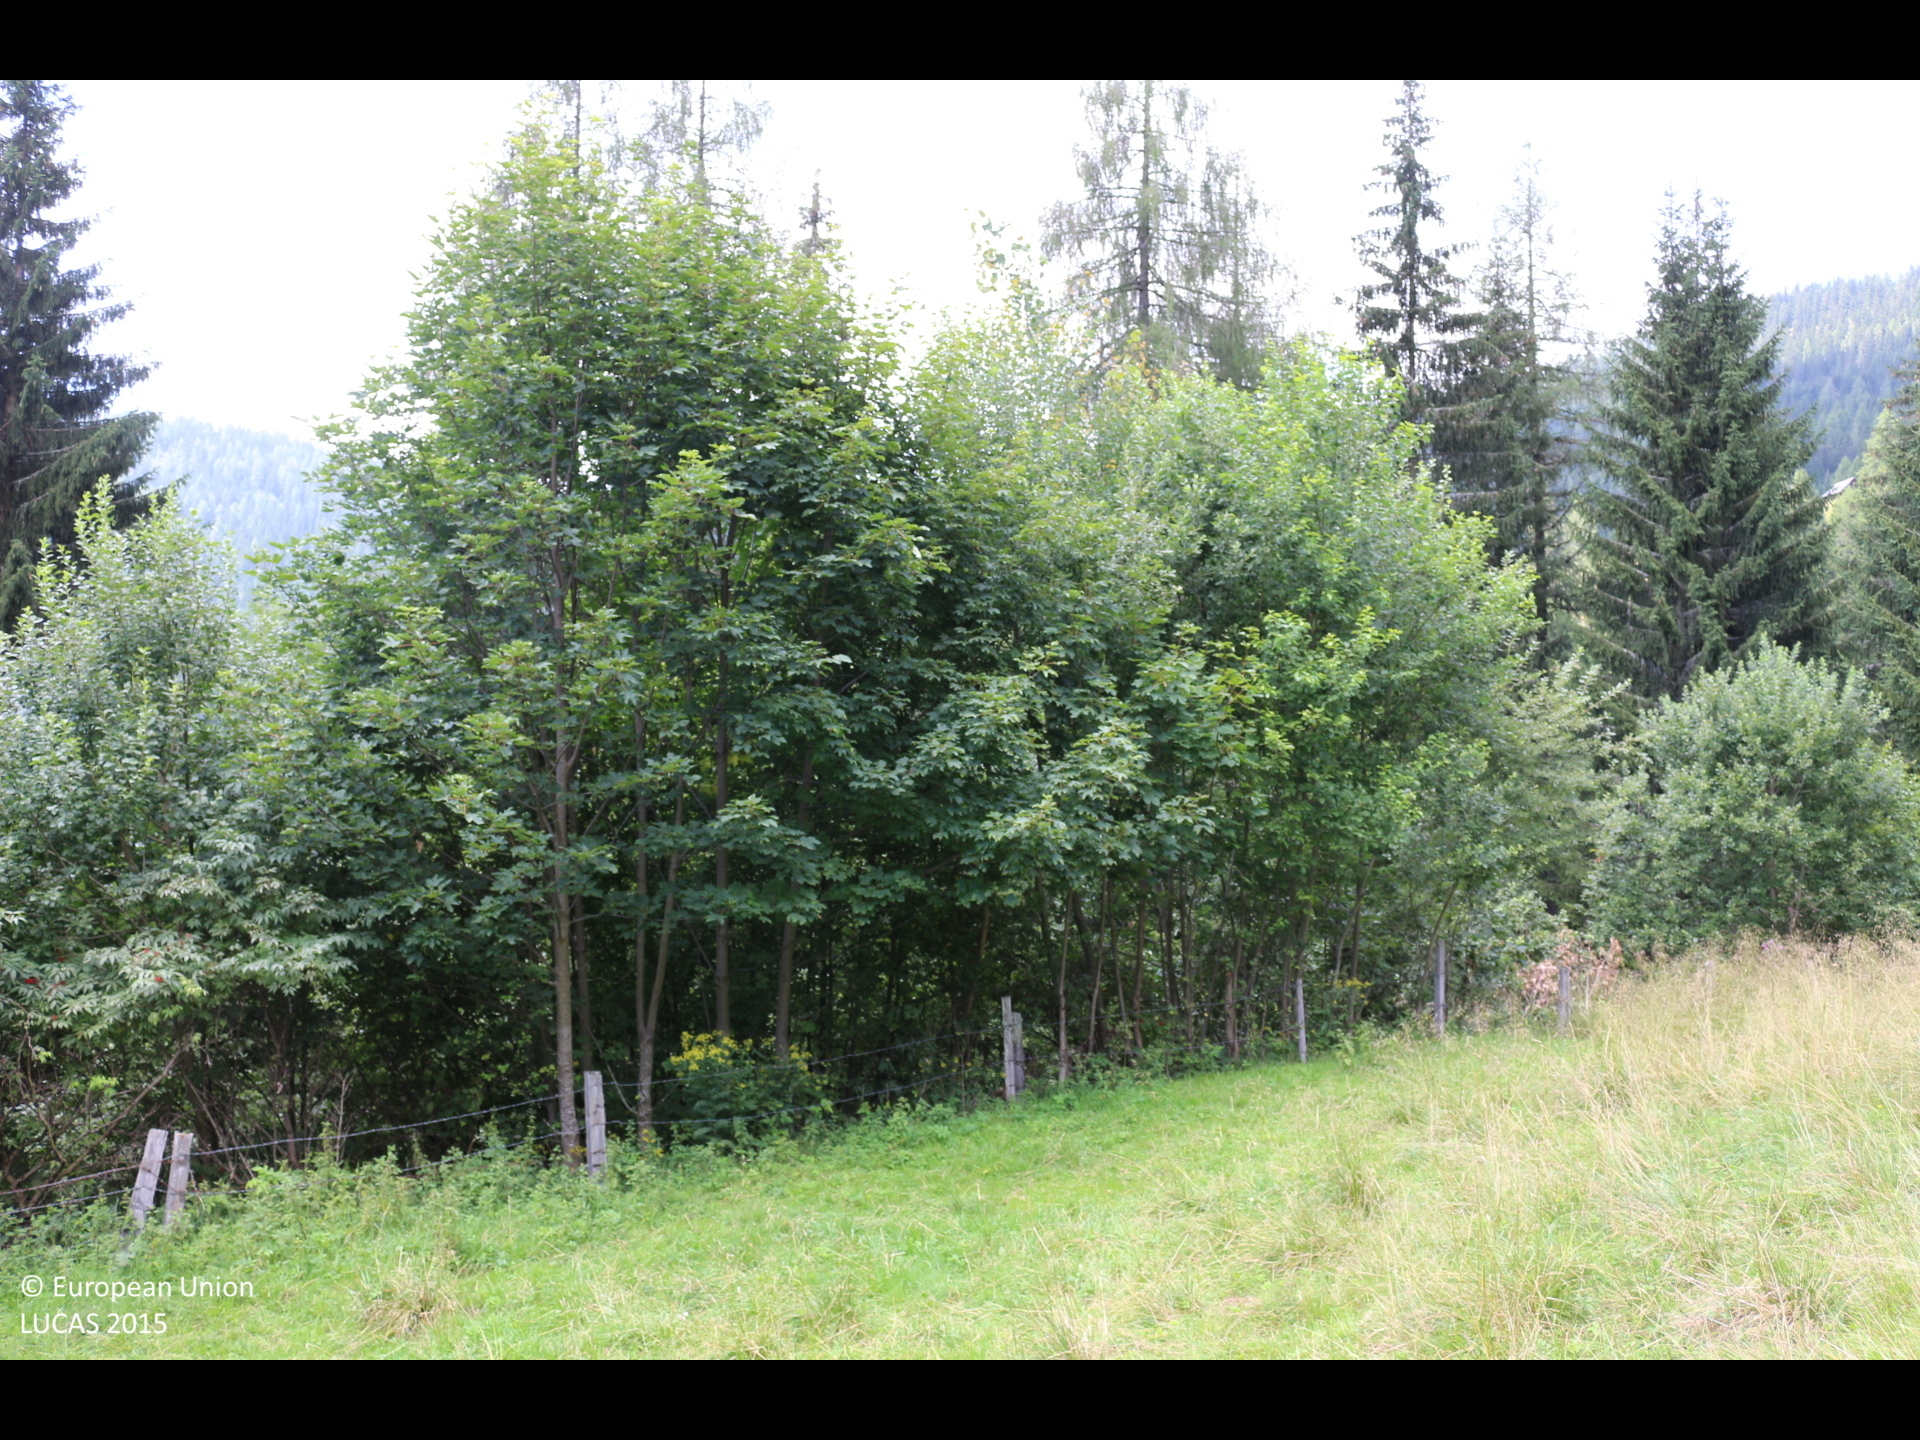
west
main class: Grassland
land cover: Grassland without tree/shrub cover
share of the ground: > 75 %
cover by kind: herbaceous plants 100 %
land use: Agriculture (excluding fallow land and kitchen gardens)
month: July
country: AT
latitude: 46.7475
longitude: 13.9375
